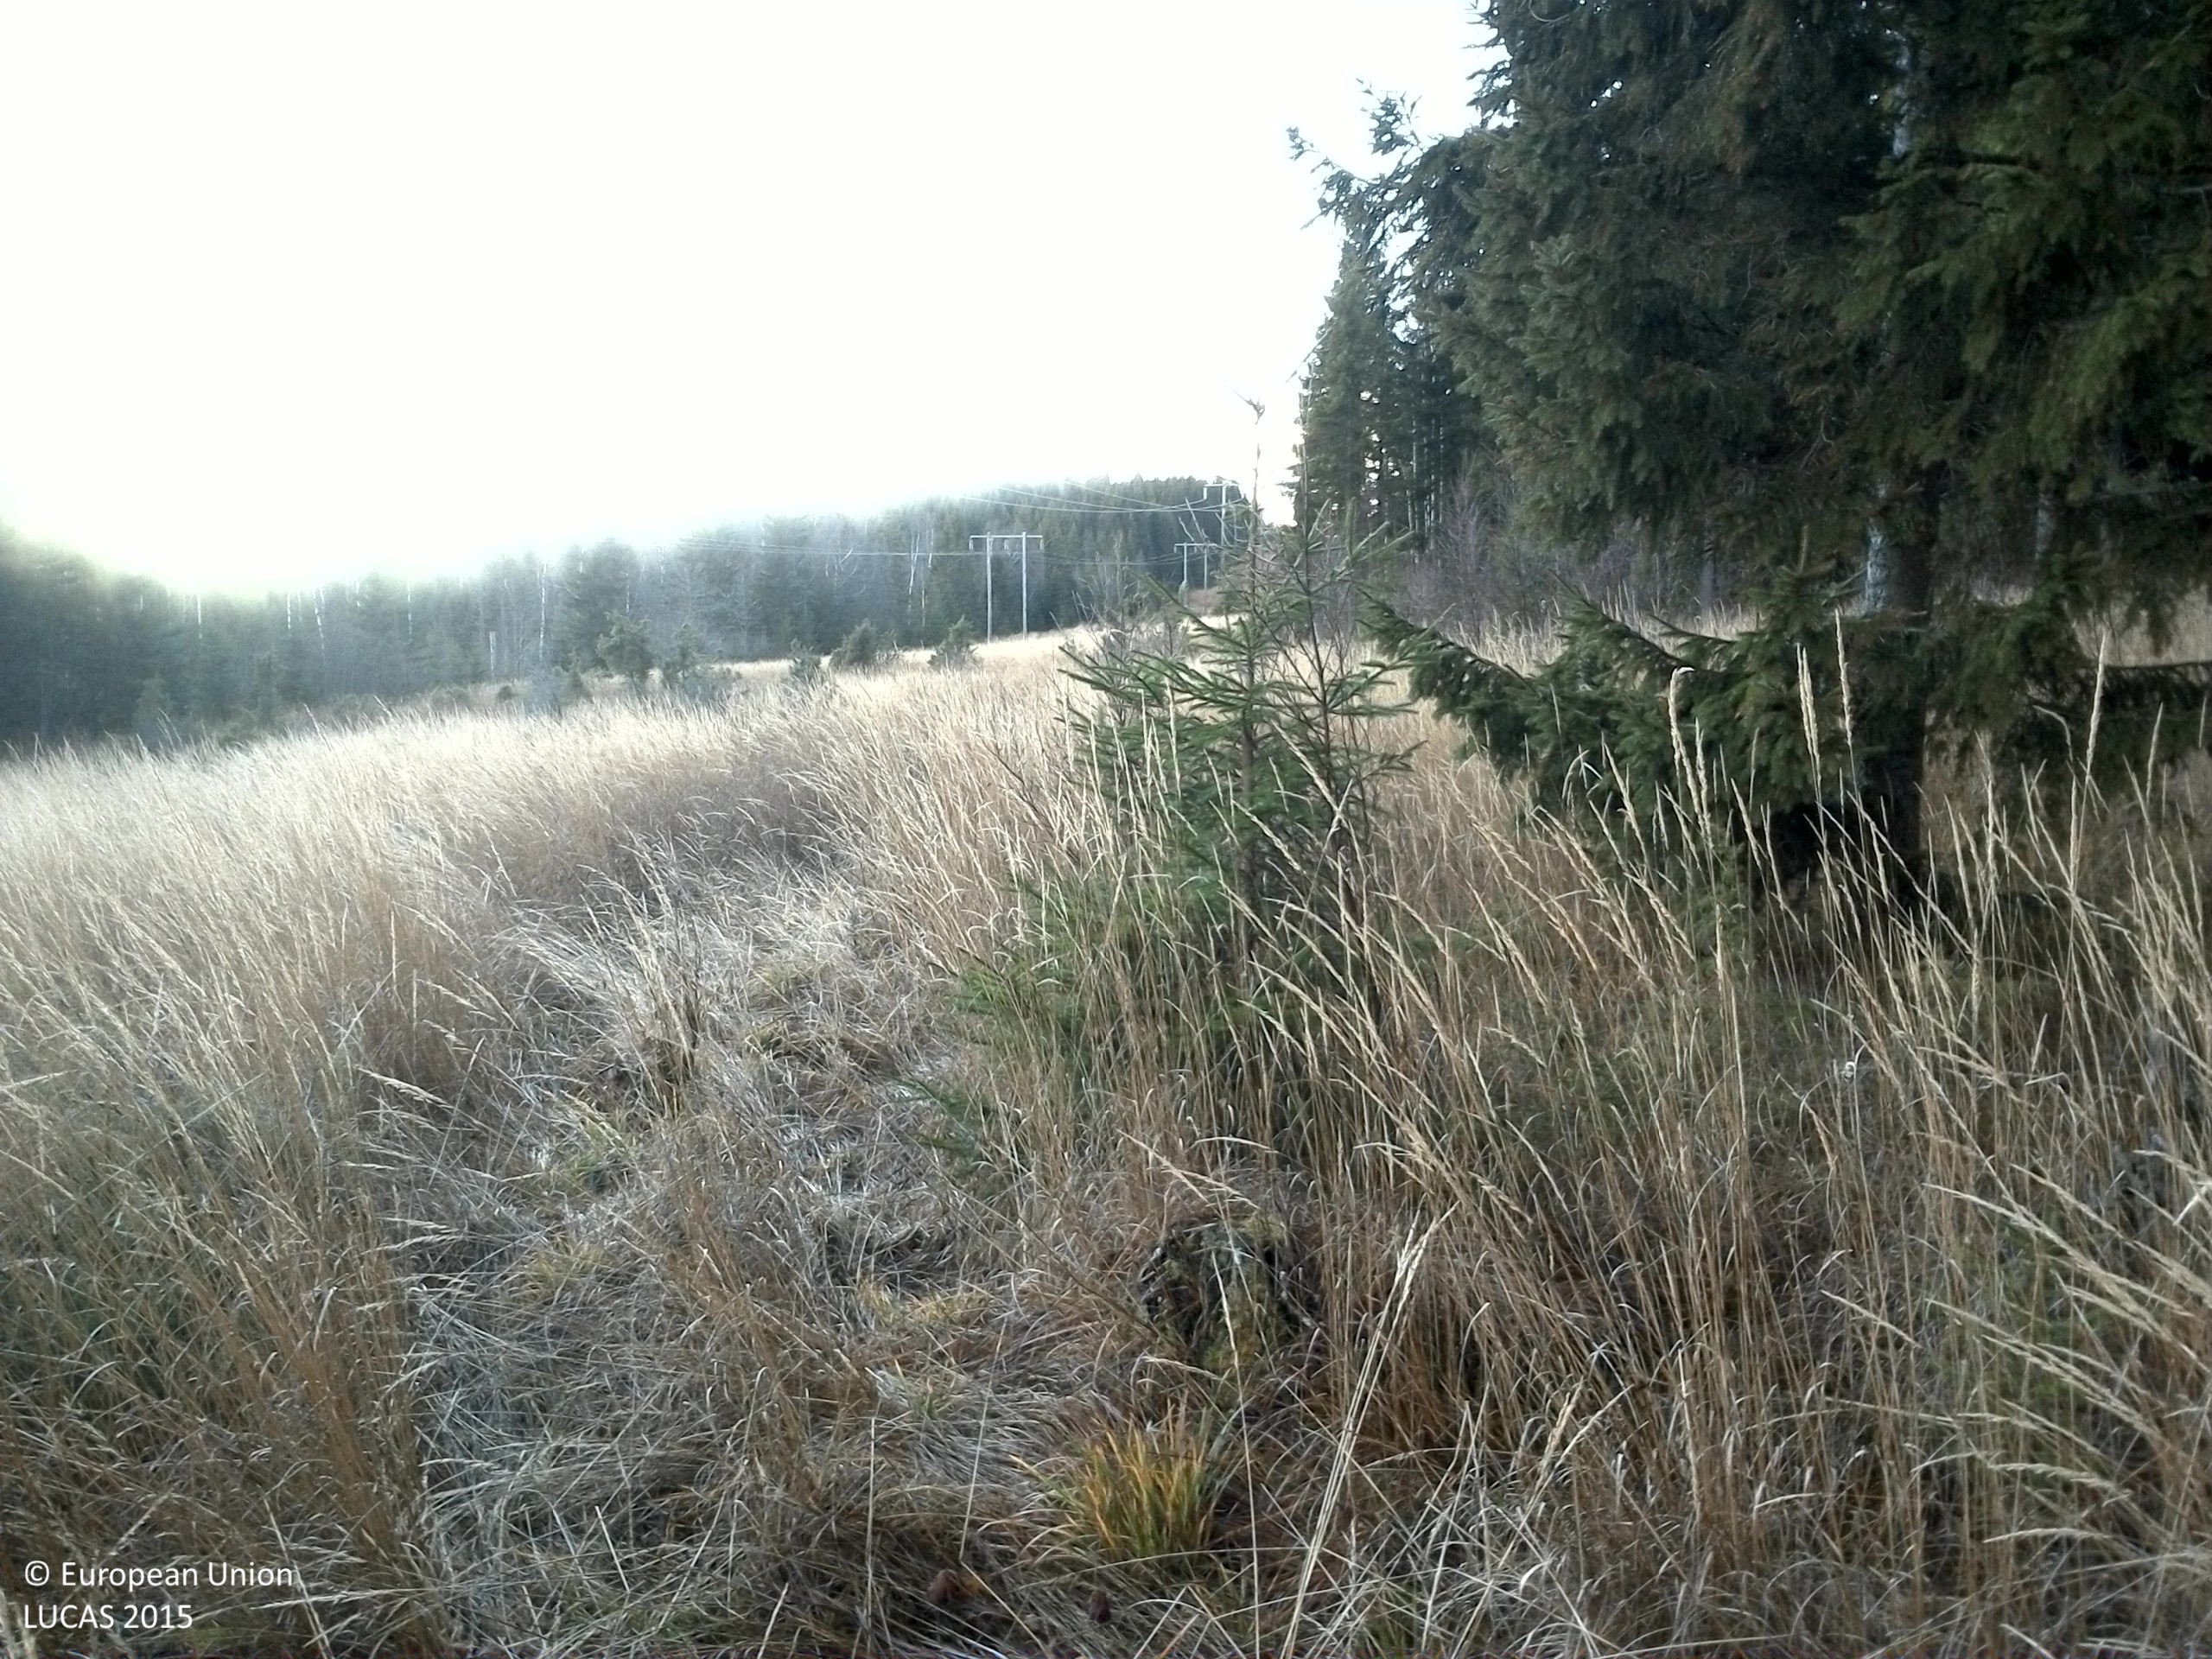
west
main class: Grassland
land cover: Grassland with sparse tree/shrub cover
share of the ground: > 75 %
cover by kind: herbaceous plants 95 %, coniferous forest trees 5 %
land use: Electricity, gas and thermal power distribution
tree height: < 5 m
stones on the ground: < 10 %
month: November
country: SE
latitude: 60.0521
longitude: 15.1074
